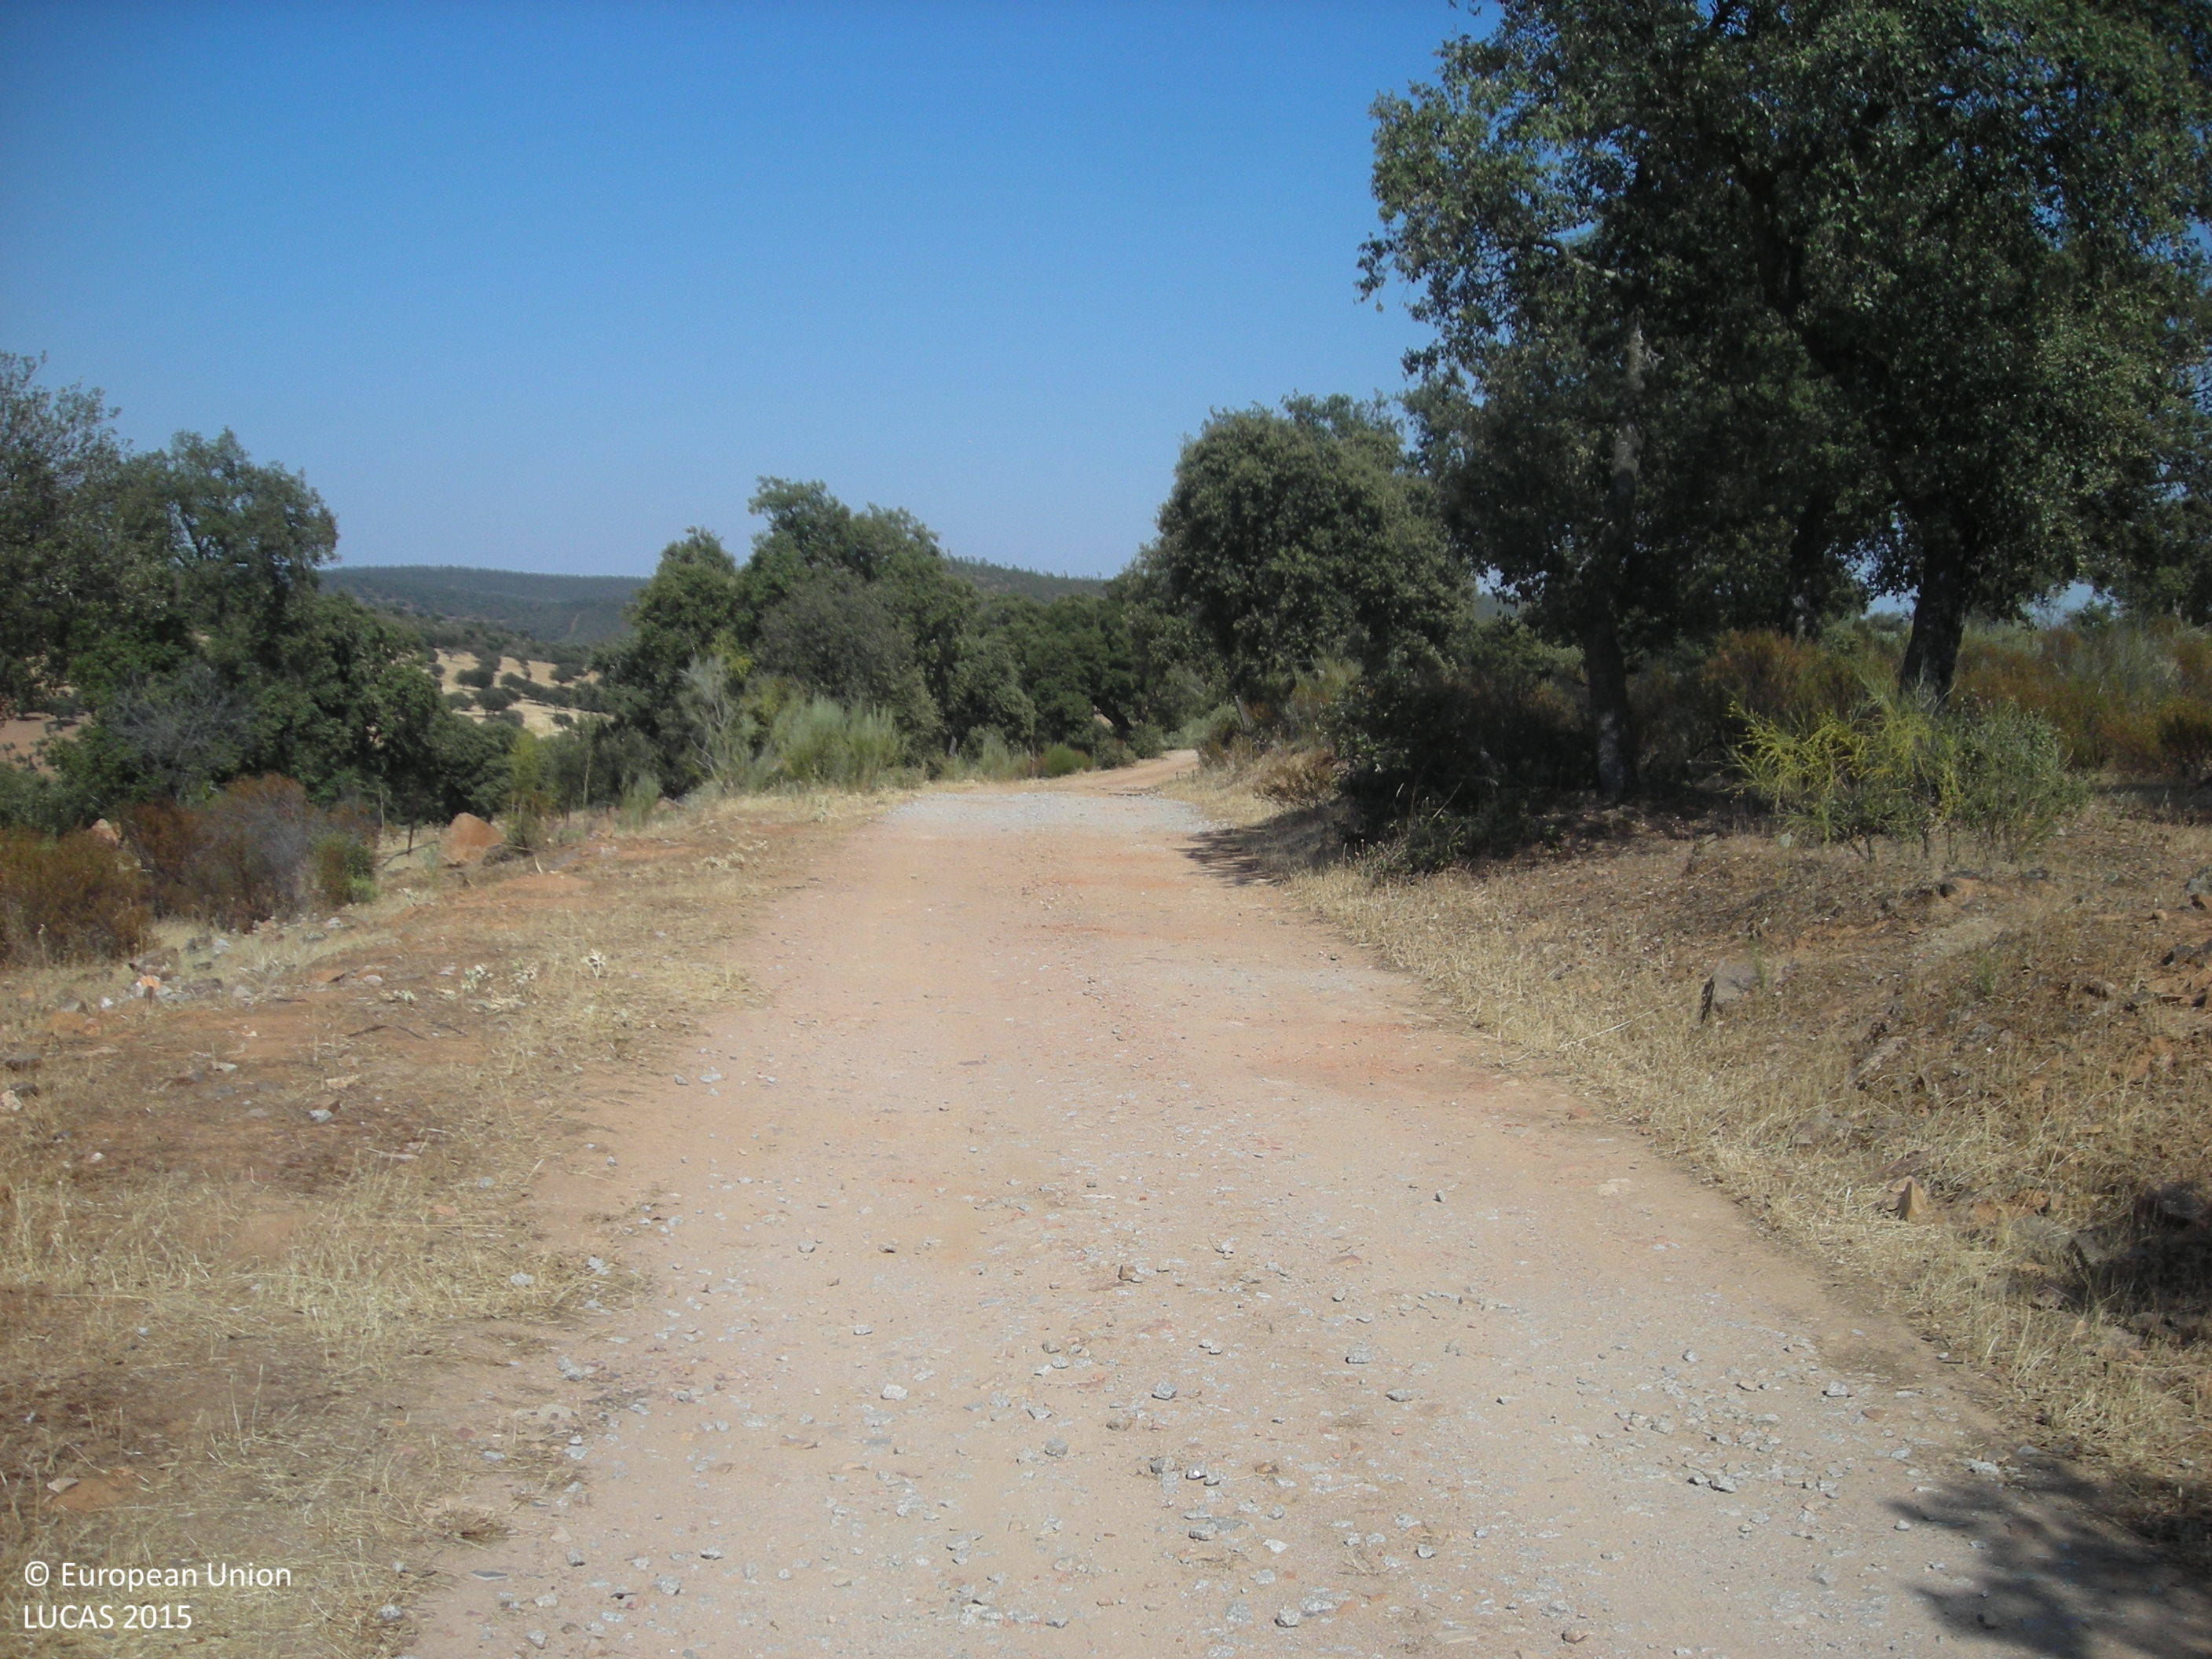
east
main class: Woodland
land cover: Broadleaved woodland
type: broadleaved evergreen forest
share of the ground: > 75 %
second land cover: Grassland without tree/shrub cover
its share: 50 - 75 %
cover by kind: herbaceous plants 60 %, broadleaved forest trees 40 %
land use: Forestry
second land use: Agriculture (excluding fallow land and kitchen gardens)
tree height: > 5 m
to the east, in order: Broadleaved woodland; Grassland without tree/shrub cover
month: June
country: ES
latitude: 38.5981
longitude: -5.7603
